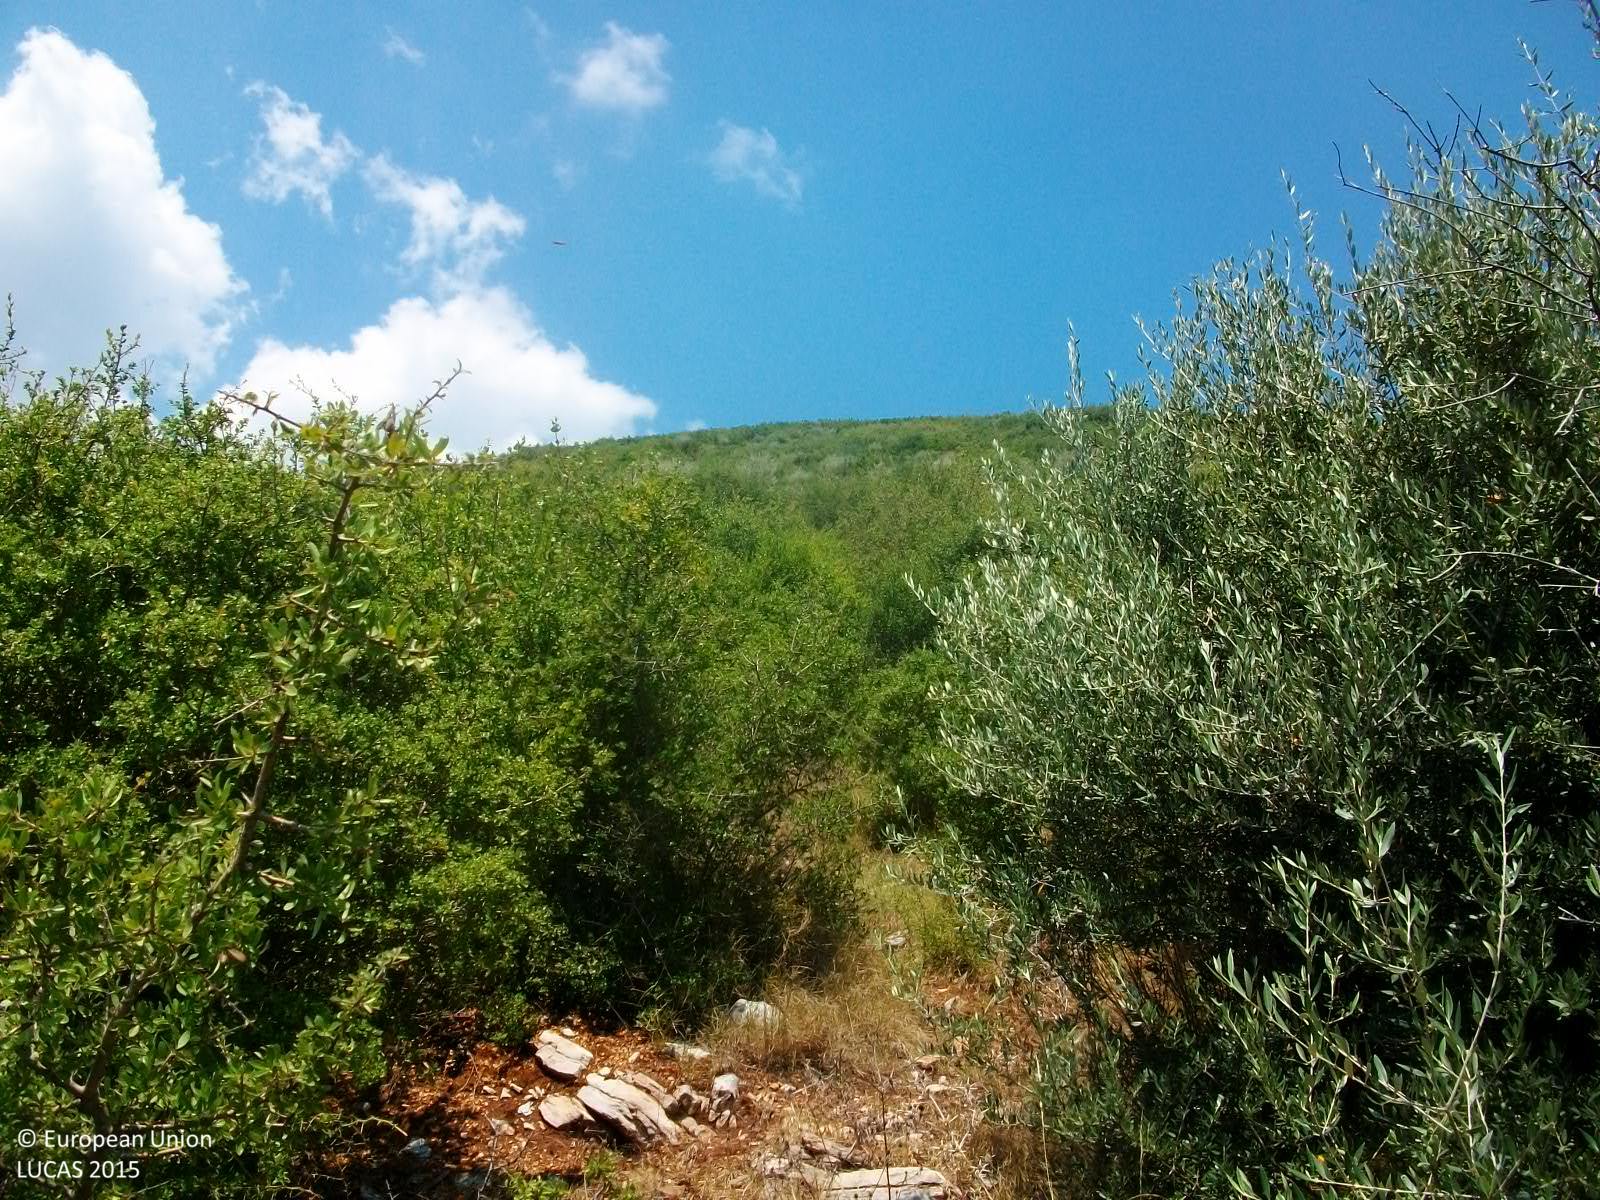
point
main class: Shrubland
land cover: Shrubland without tree cover
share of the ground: > 75 %
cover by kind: shrubs 100 %
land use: Semi-natural and natural areas not in use
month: July
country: GR
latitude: 37.4845
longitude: 21.9579
